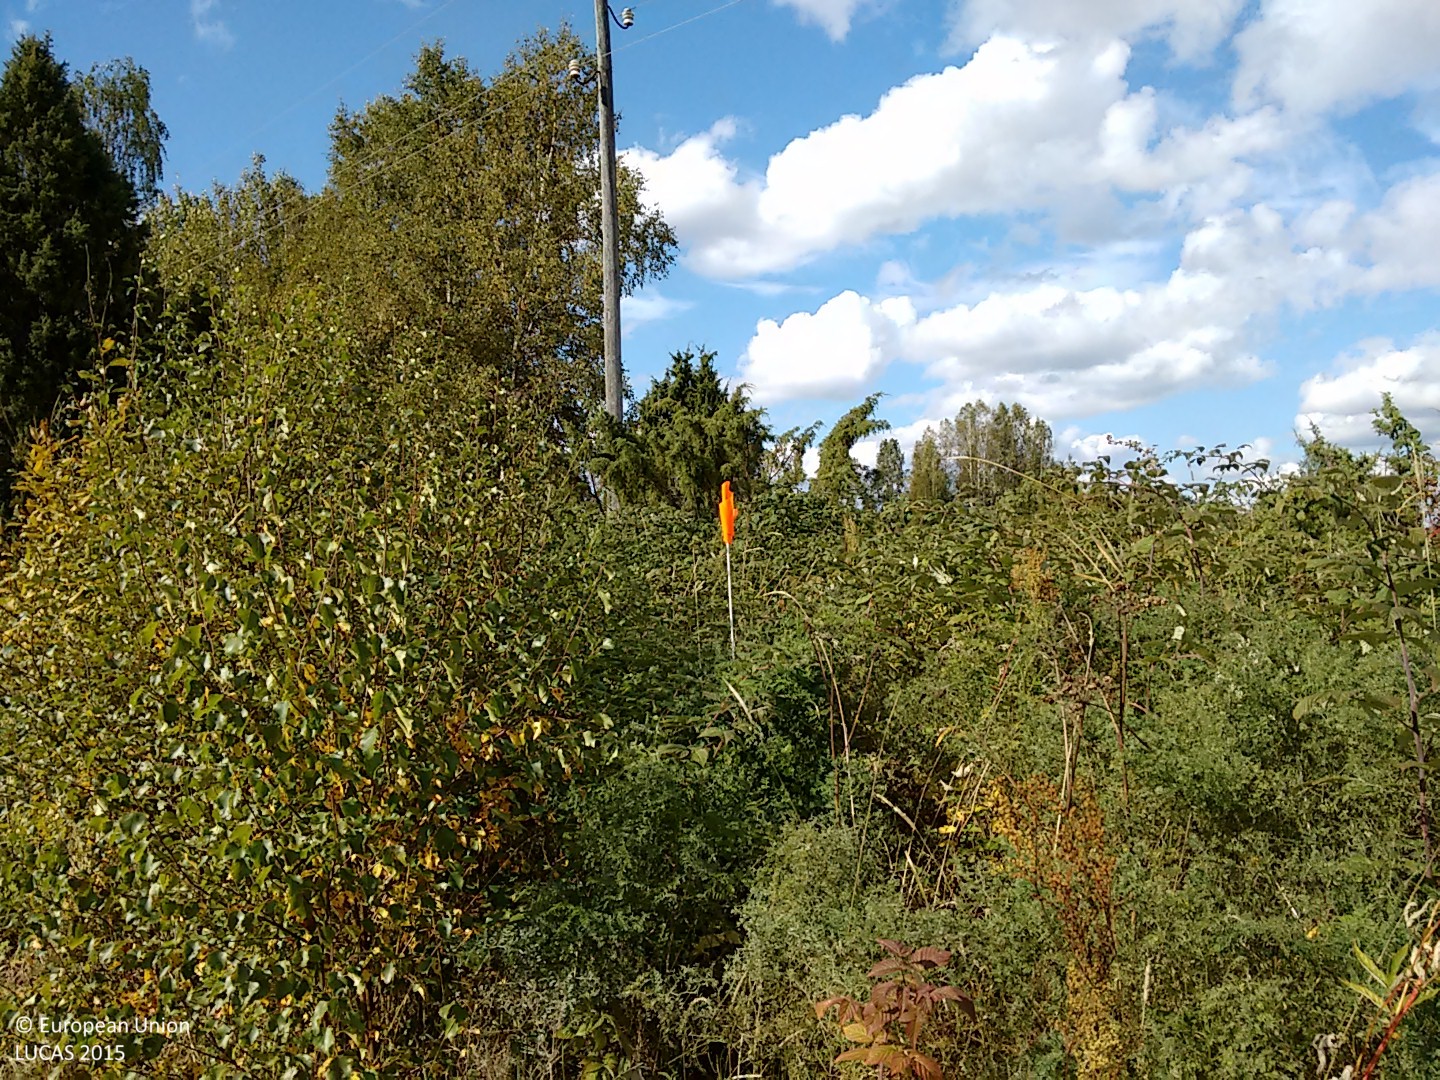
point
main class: Shrubland
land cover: Shrubland with sparse tree cover
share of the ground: > 75 %
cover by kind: shrubs 95 %, broadleaved forest trees 5 %
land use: Agriculture (excluding fallow land and kitchen gardens)
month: September
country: FI
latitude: 61.0234
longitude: 21.6952
